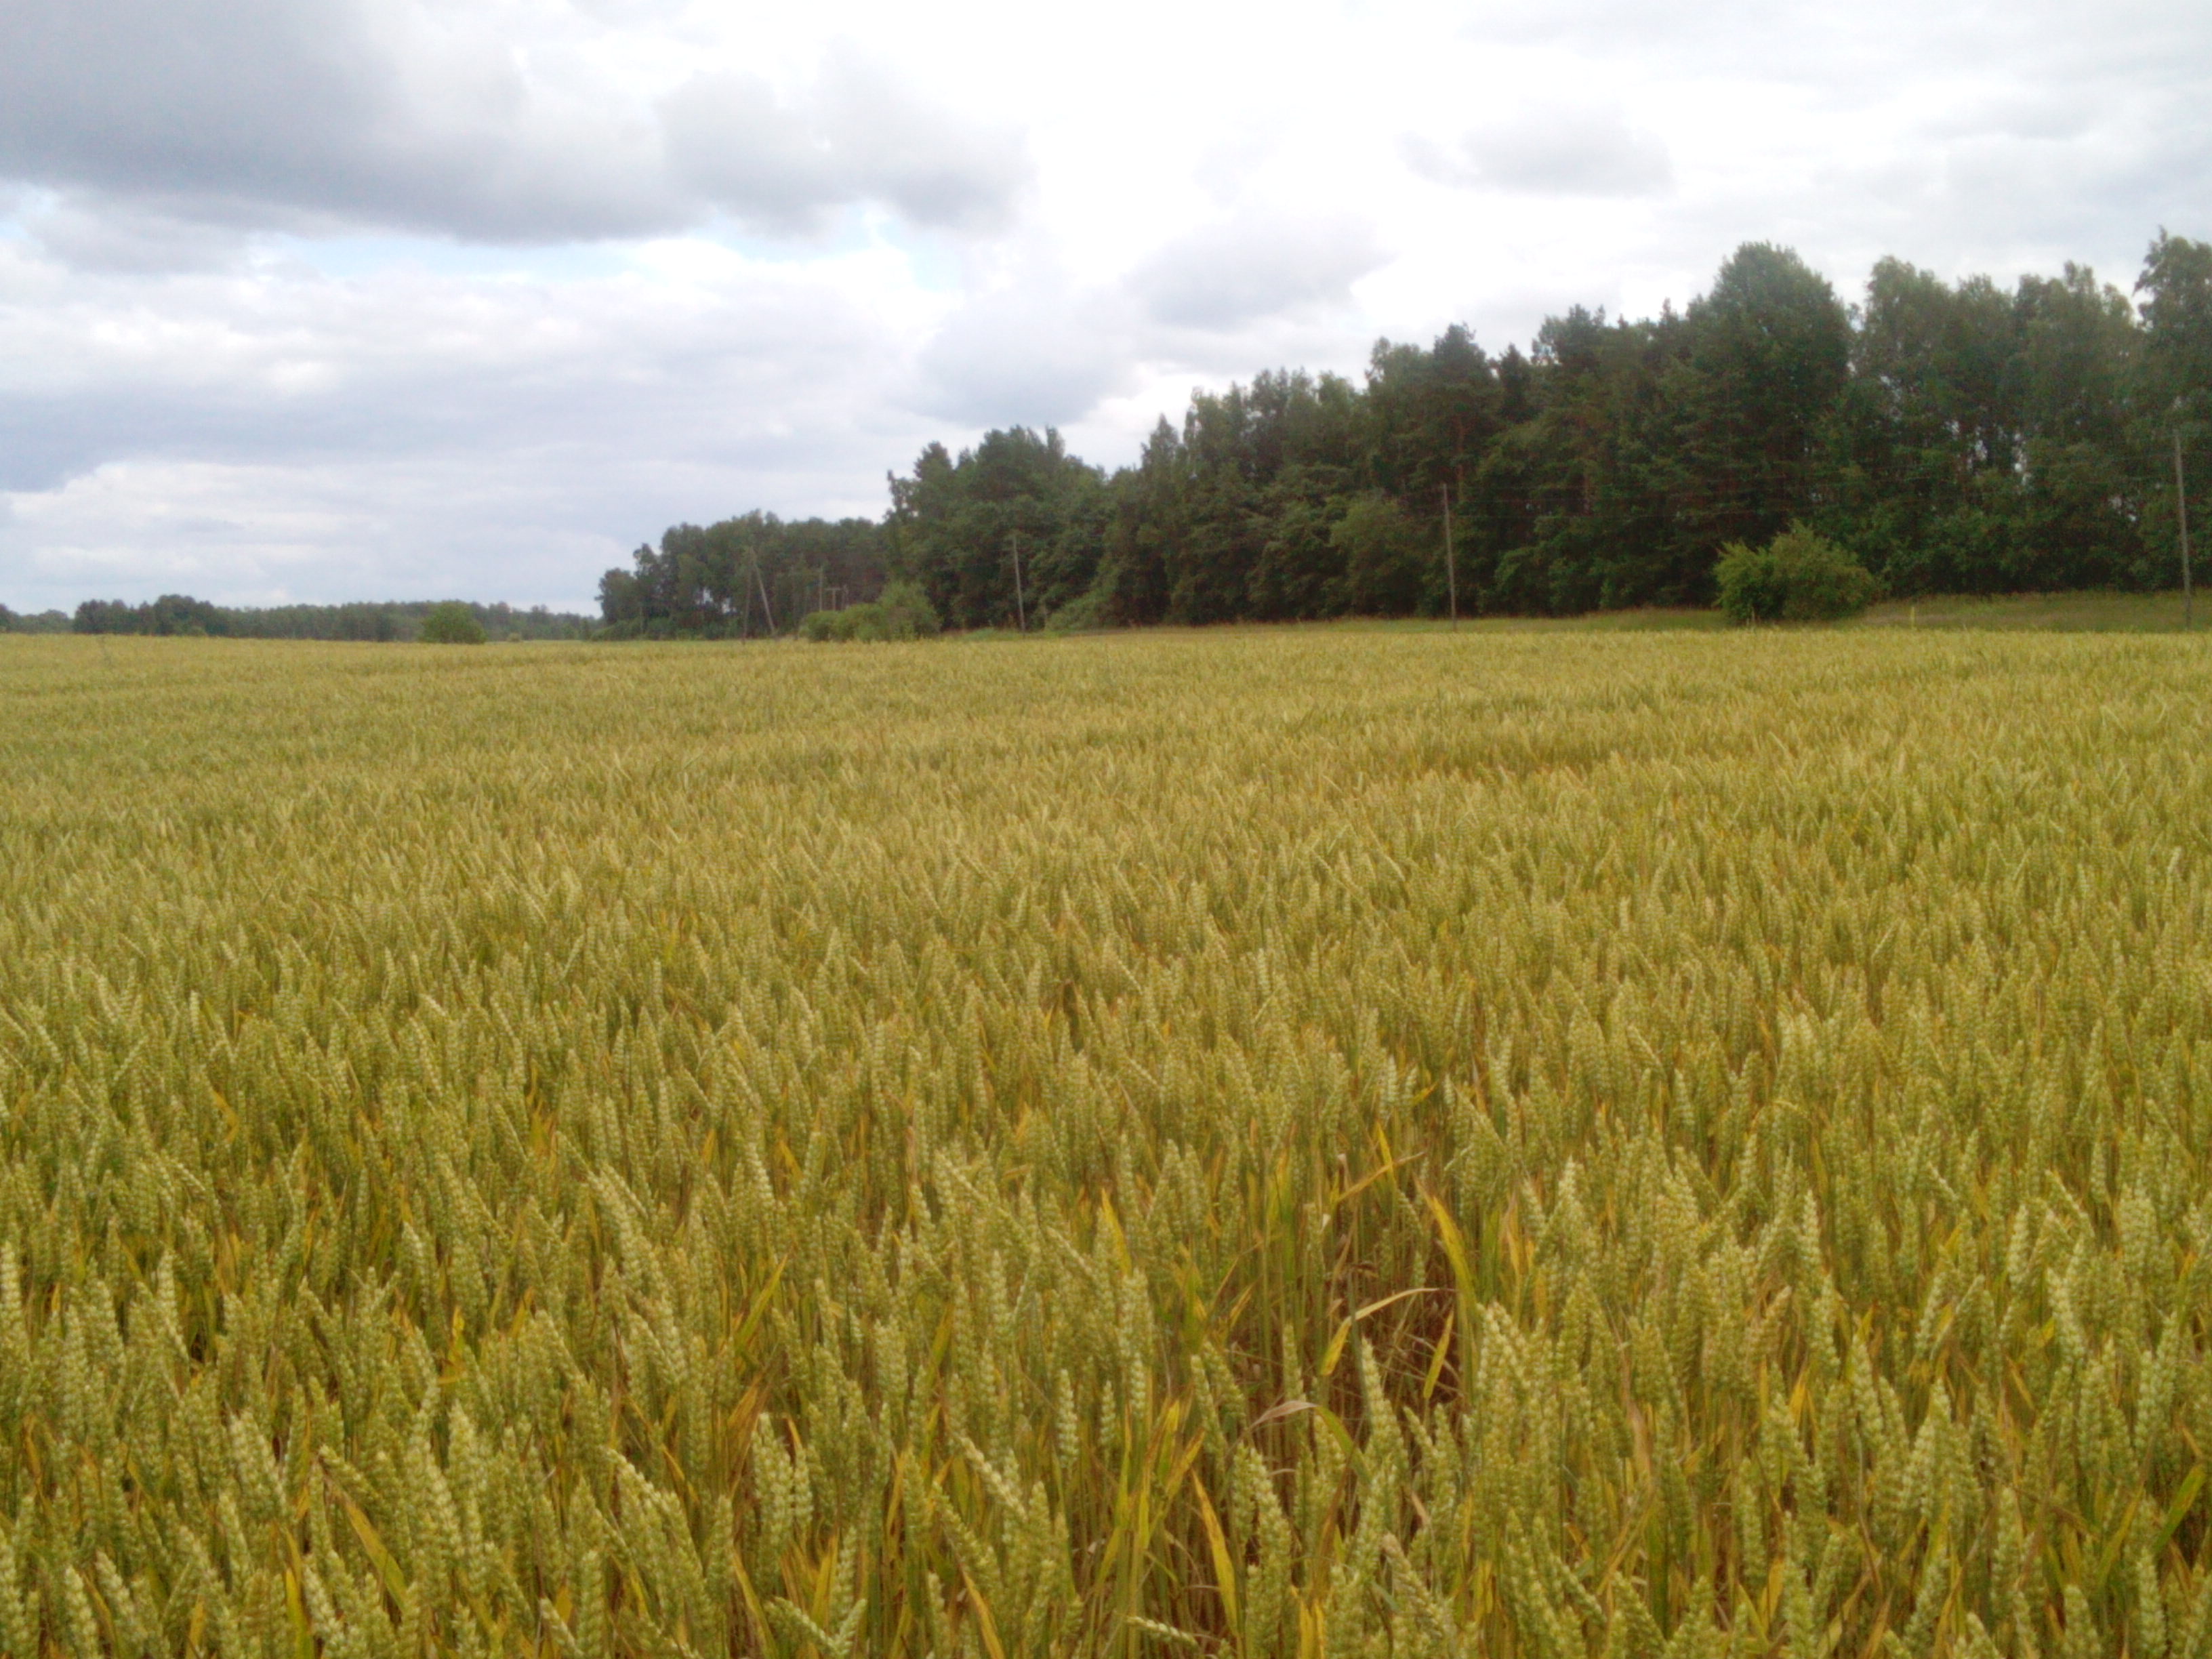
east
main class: Cropland
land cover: Common wheat
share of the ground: > 75 %
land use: Agriculture (excluding fallow land and kitchen gardens)
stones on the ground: < 10 %
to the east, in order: Common wheat
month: July
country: LV
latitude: 56.8676
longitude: 22.3067
